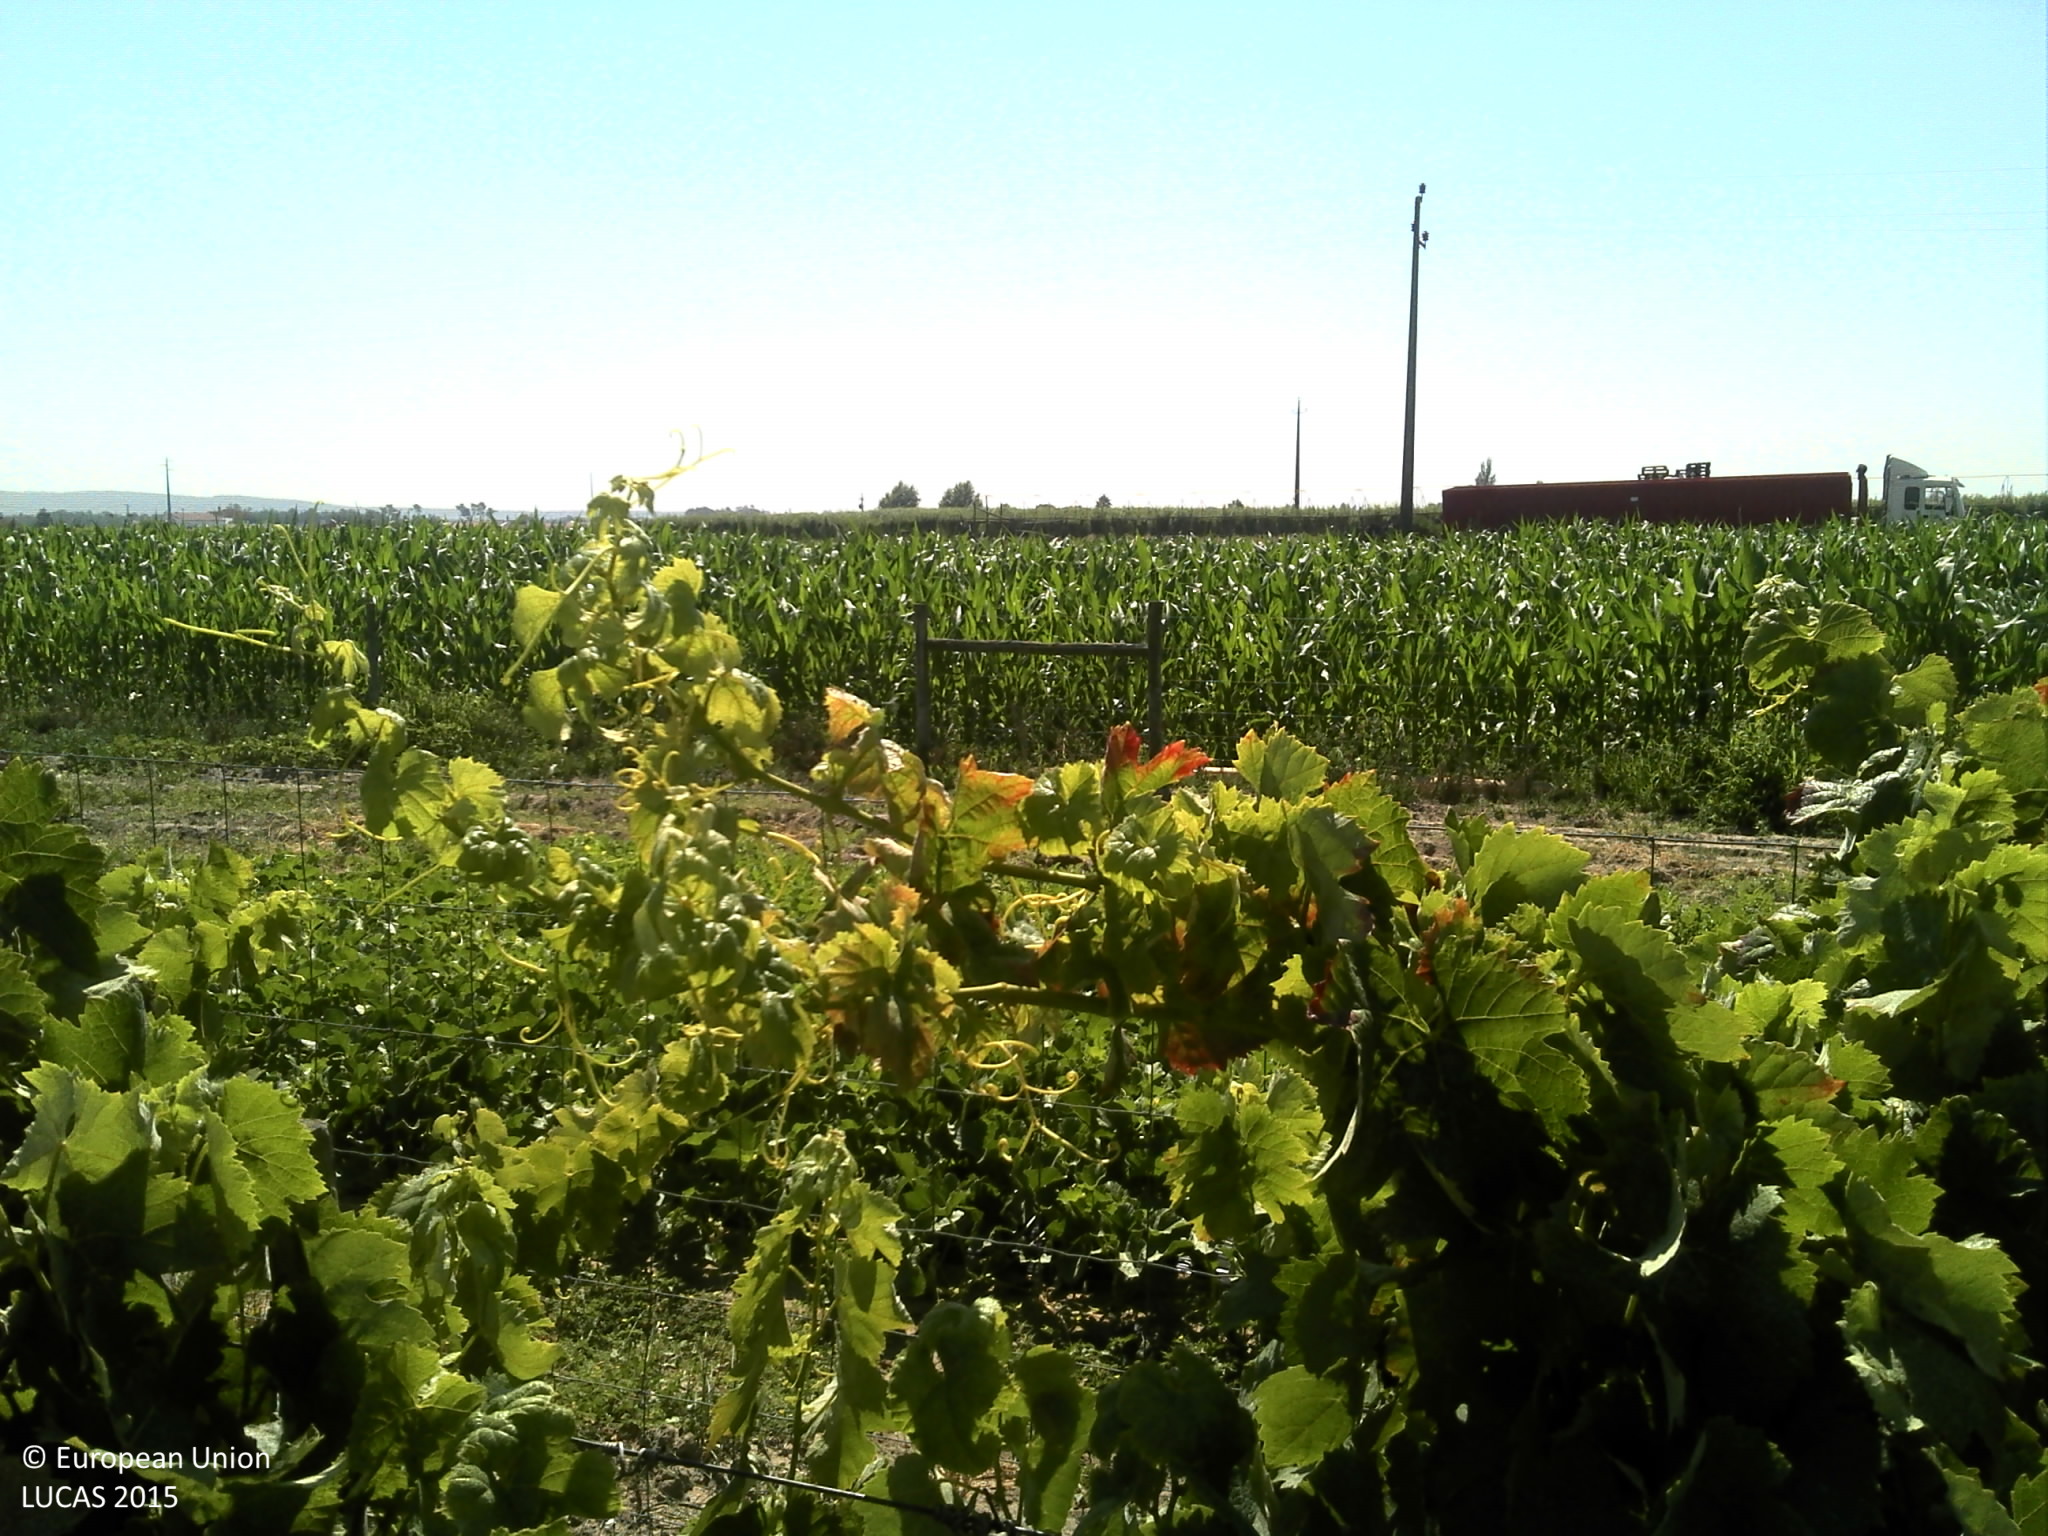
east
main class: Cropland
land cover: Vineyards
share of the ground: 25 - 50 %
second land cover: Other bare soil
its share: > 75 %
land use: Agriculture (excluding fallow land and kitchen gardens)
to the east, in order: Vineyards; Other bare soil; Vineyards; Fences; Other fresh vegetables; Fences; Maize; Electric lines; Fences; Spontaneously vegetated surfaces; Fences; Grassland without tree/shrub cover; Electric lines; Grassland without tree/shrub cover; Fences; Vineyards; Fences; Spontaneously vegetated surfaces
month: June
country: PT
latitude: 39.1258
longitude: -8.6582
